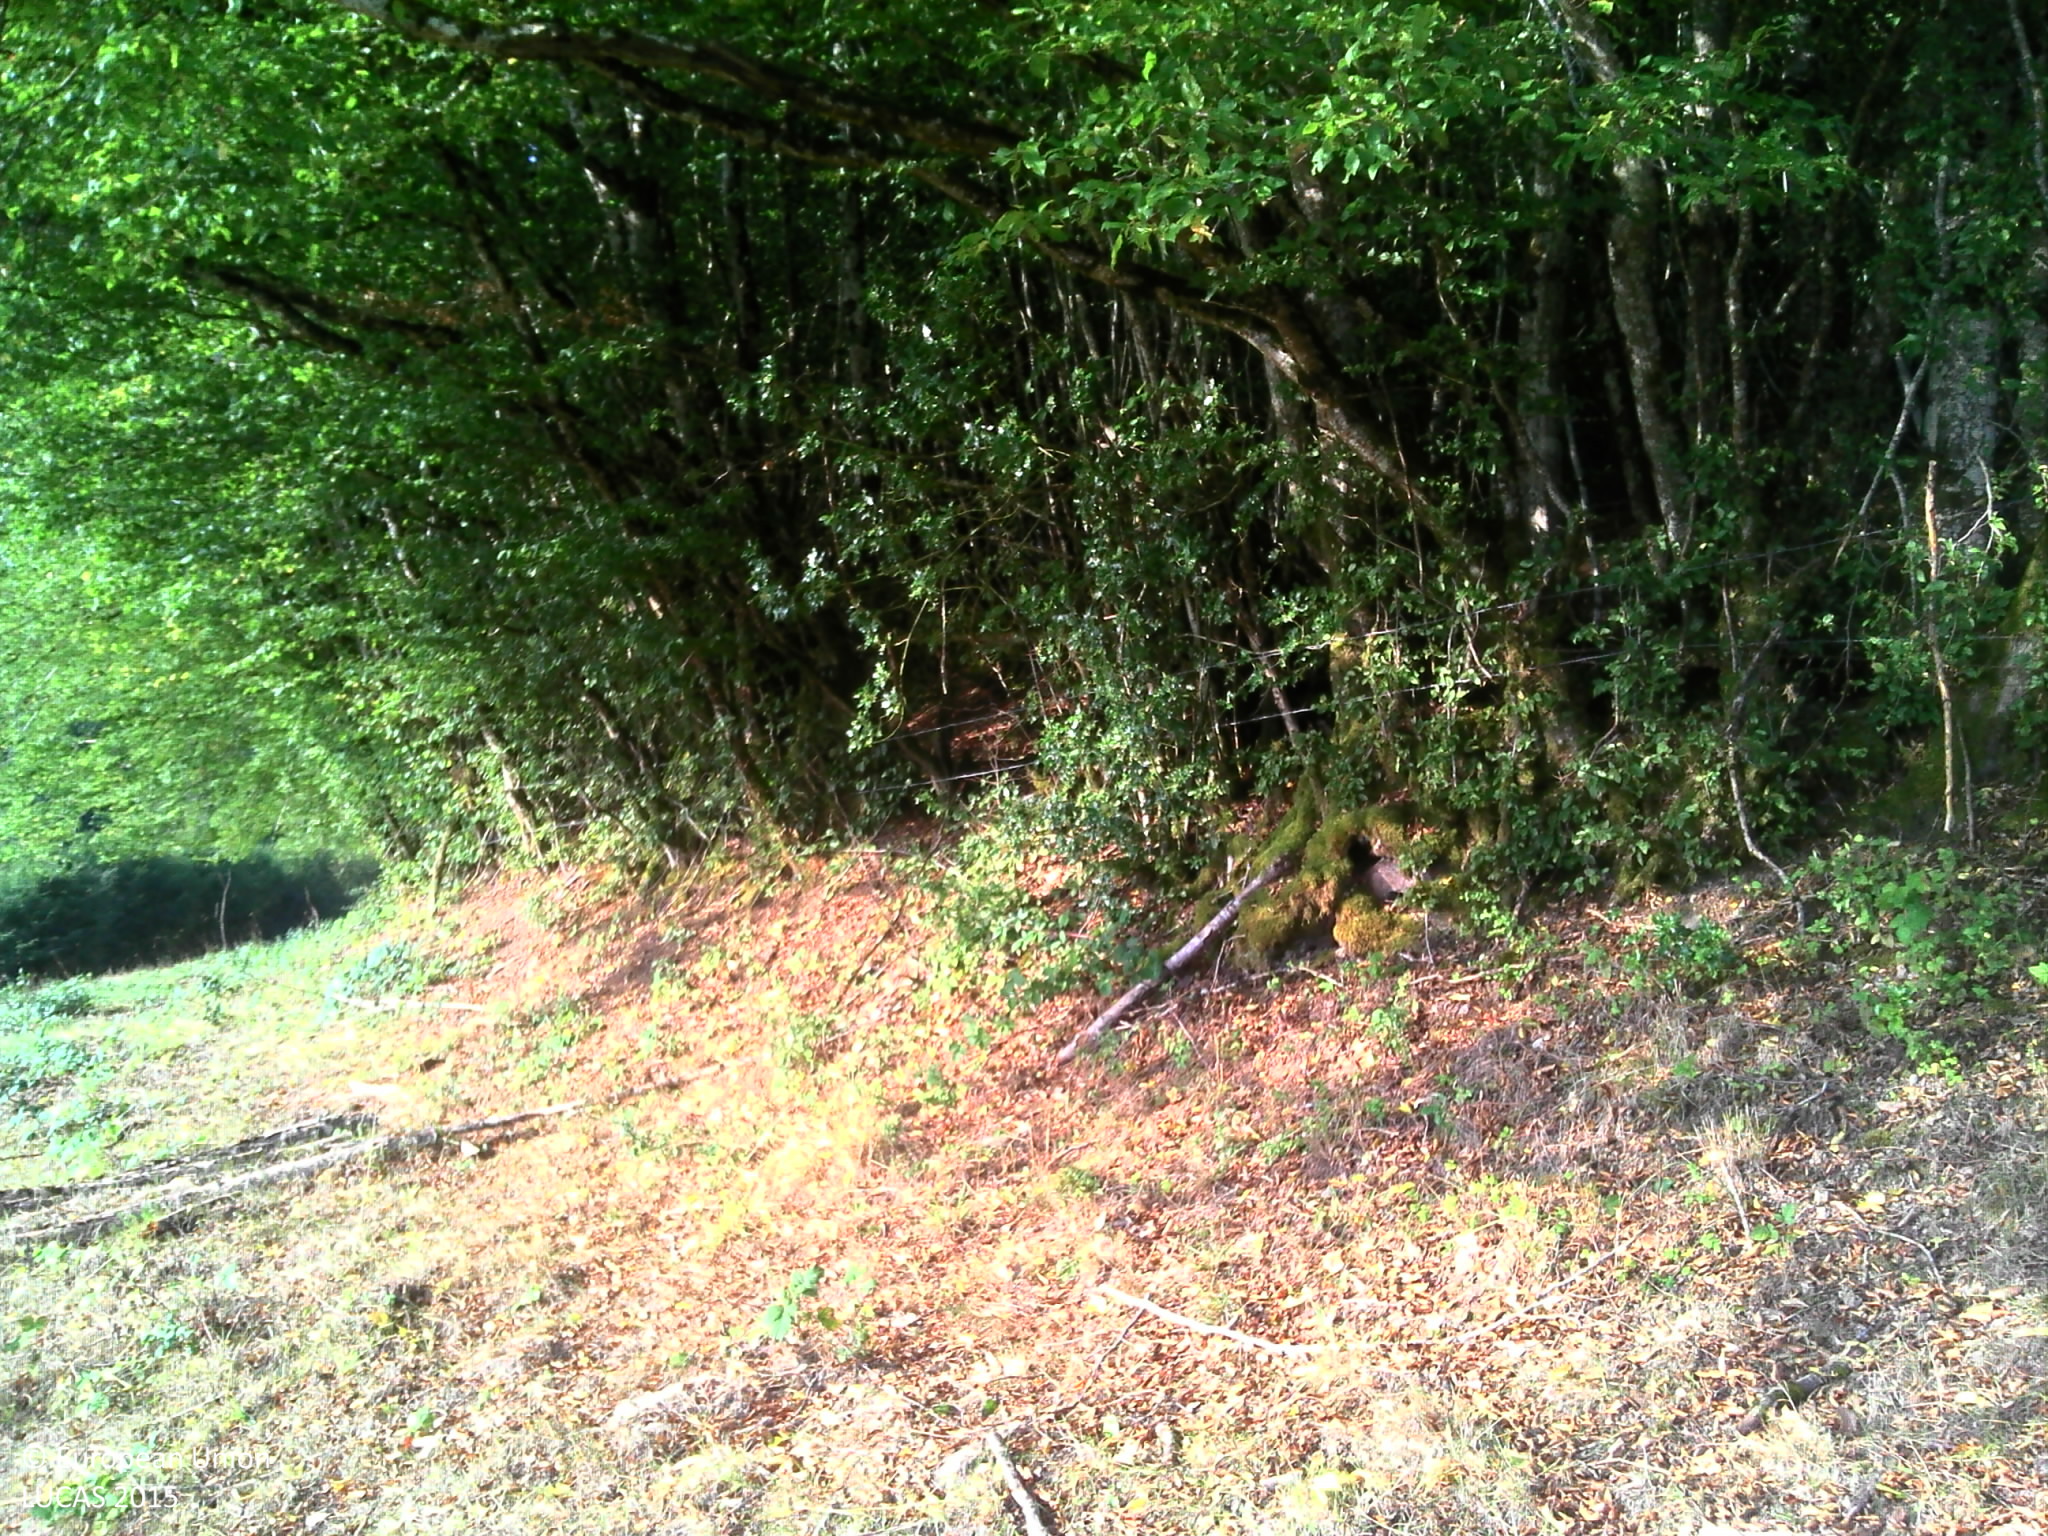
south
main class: Shrubland
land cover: Shrubland without tree cover
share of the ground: > 75 %
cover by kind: shrubs 50 %, herbaceous plants 50 %
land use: Forestry
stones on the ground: < 10 %
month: August
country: FR
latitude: 47.1028
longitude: 4.3205
